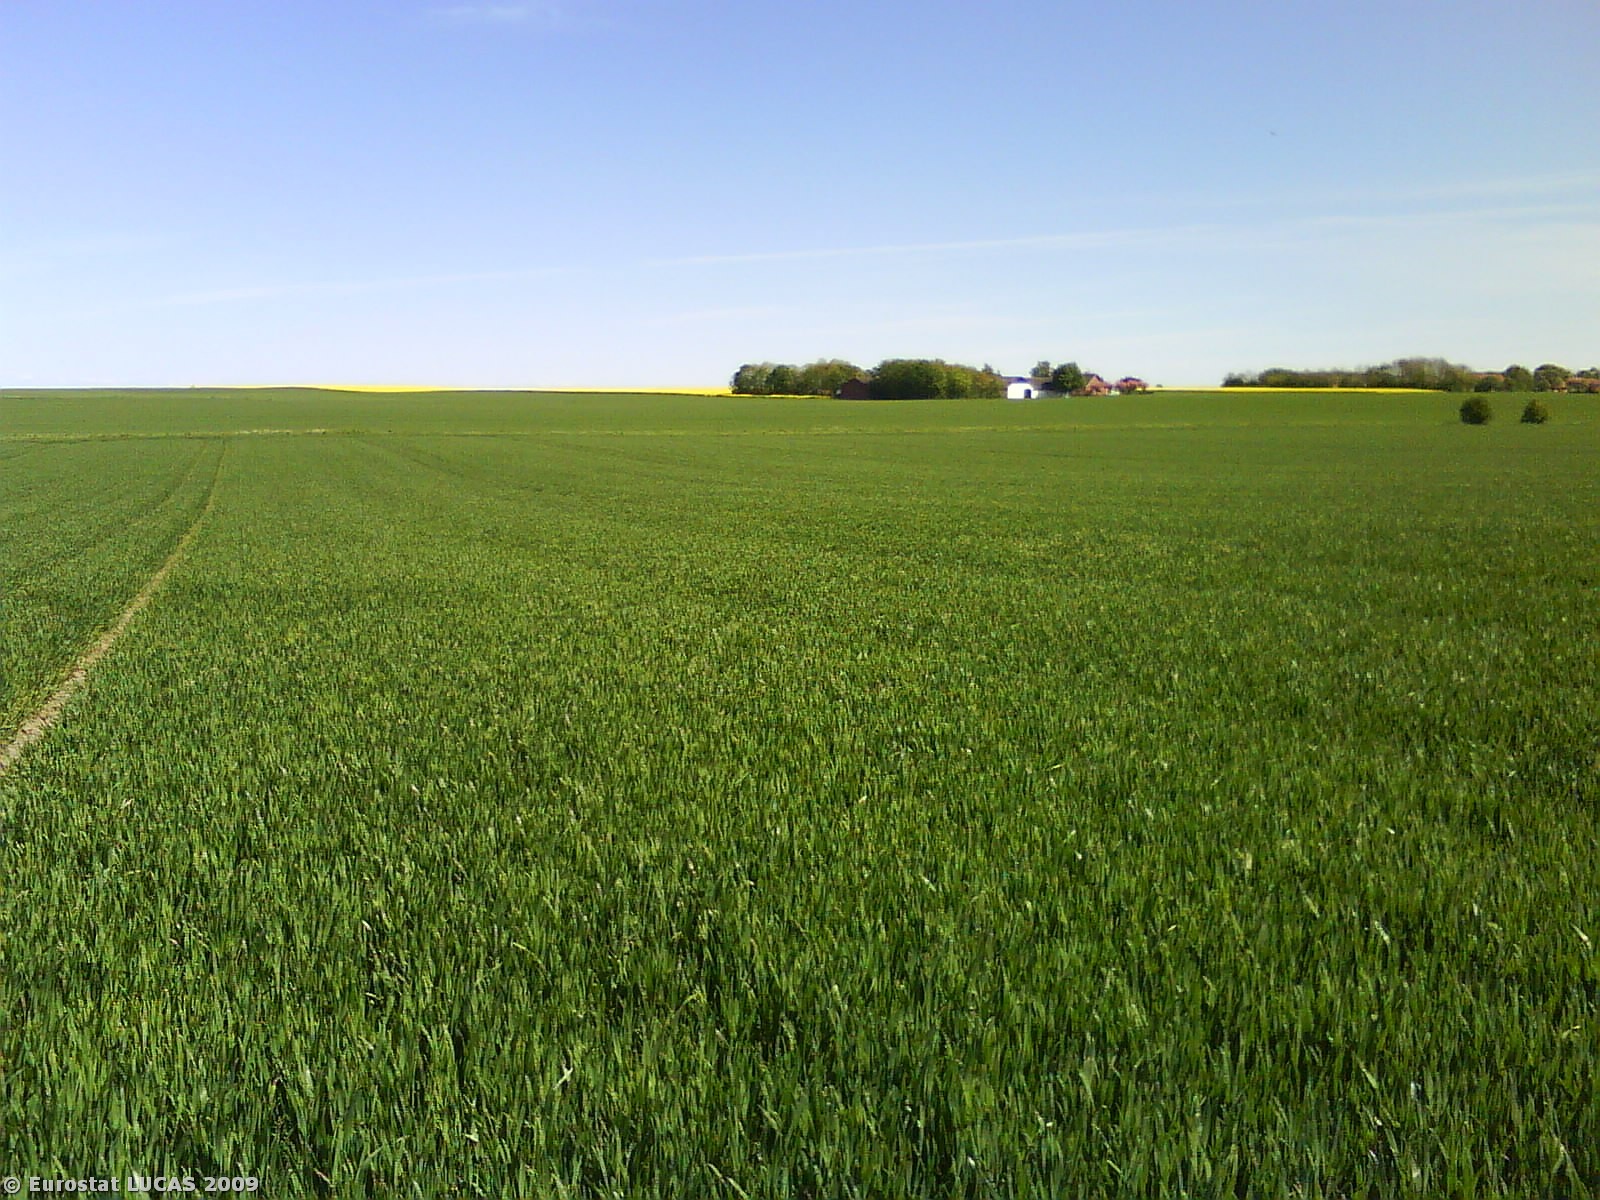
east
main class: Cropland
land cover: Common wheat
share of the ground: > 75 %
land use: Agriculture (excluding fallow land and kitchen gardens)
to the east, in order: Common wheat; Grass margins; Ditches and canals; Grass margins; Common wheat
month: May
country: DK
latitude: 56.4723
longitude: 10.8917
